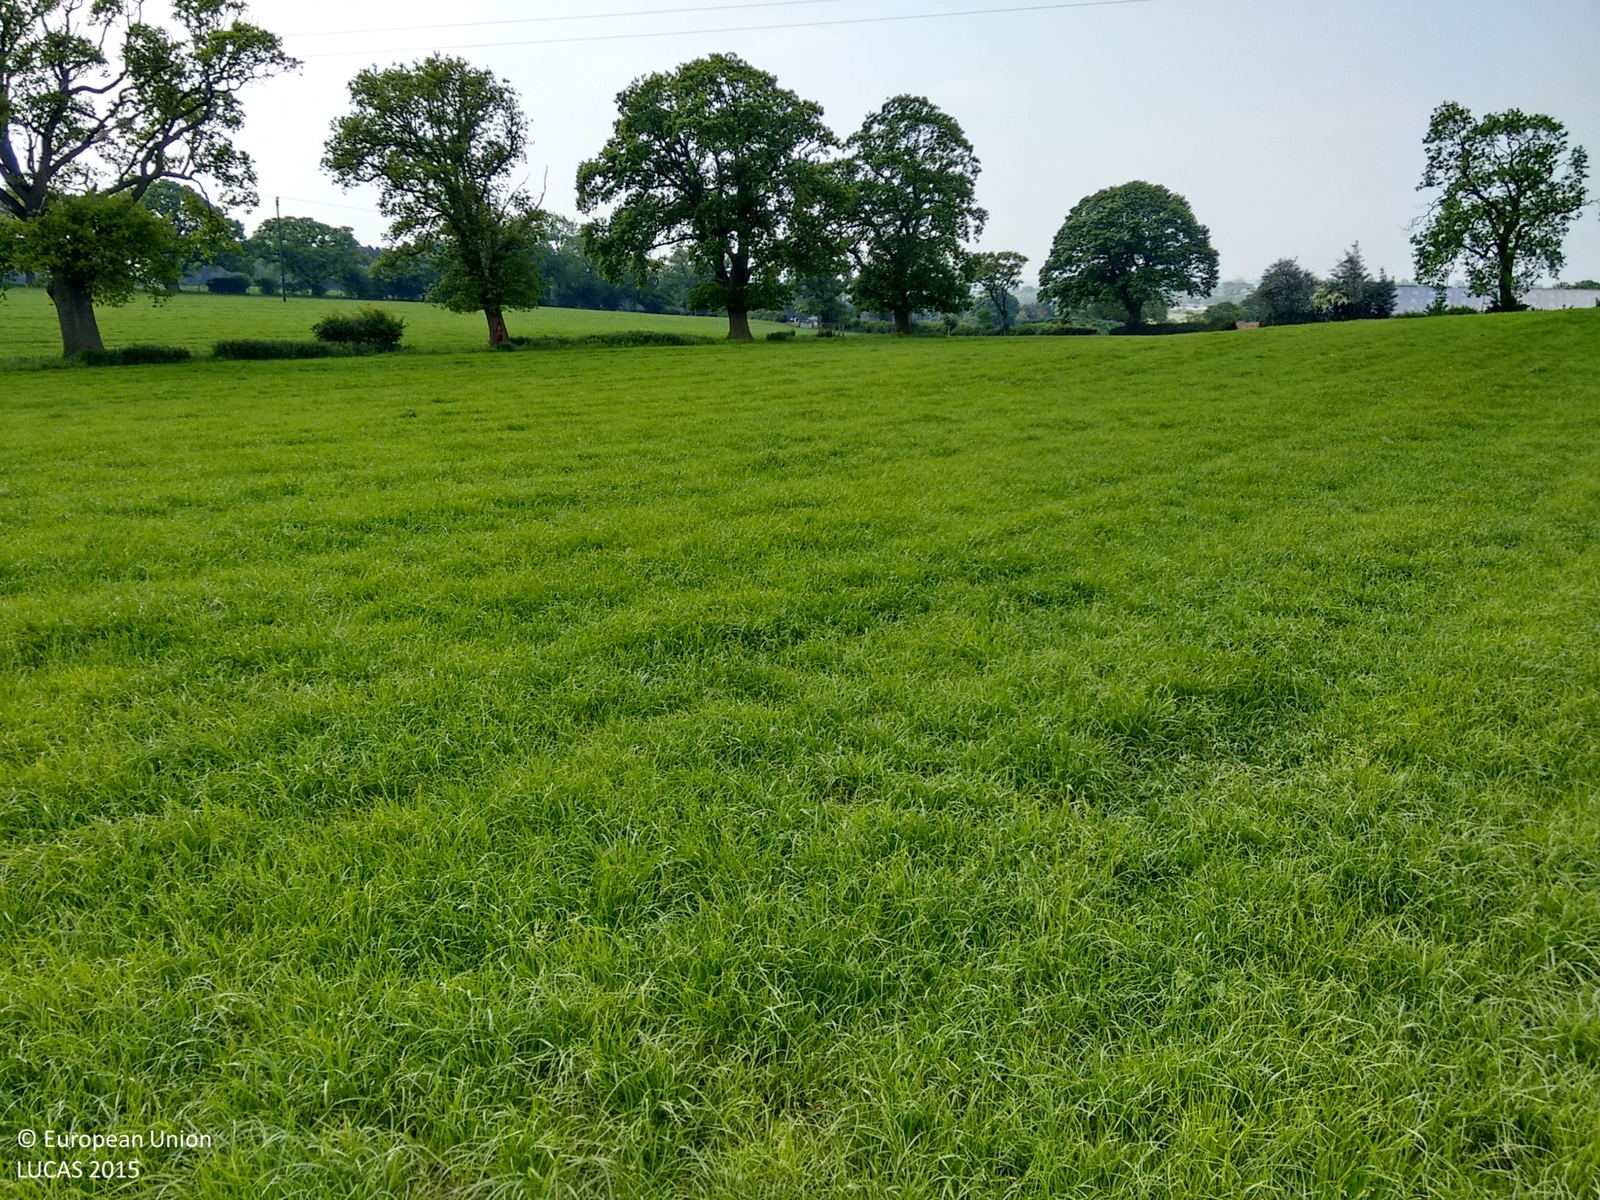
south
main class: Cropland
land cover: Temporary grasslands
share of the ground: > 75 %
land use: Agriculture (excluding fallow land and kitchen gardens)
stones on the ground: < 10 %
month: June
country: GB
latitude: 54.0612
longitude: -1.5854
